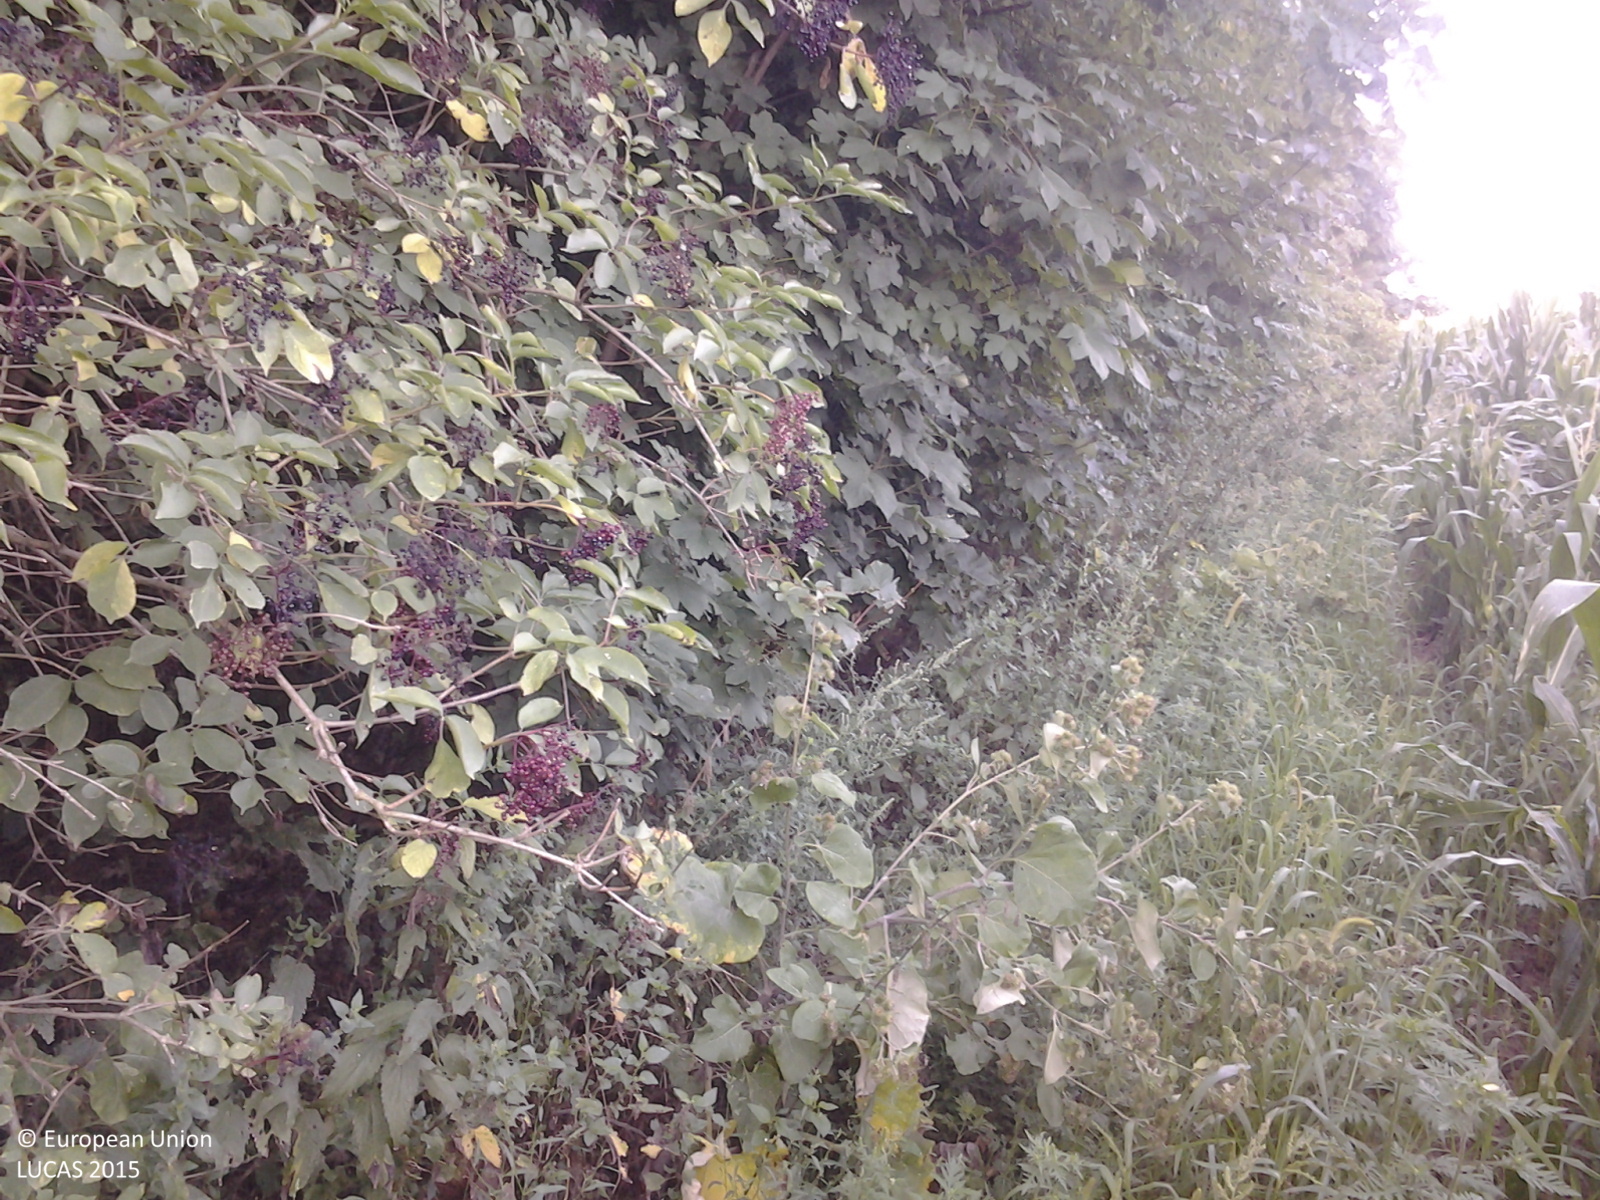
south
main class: Cropland
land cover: Maize
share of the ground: > 75 %
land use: Agriculture (excluding fallow land and kitchen gardens)
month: August
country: HU
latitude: 46.8954
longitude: 21.4719
